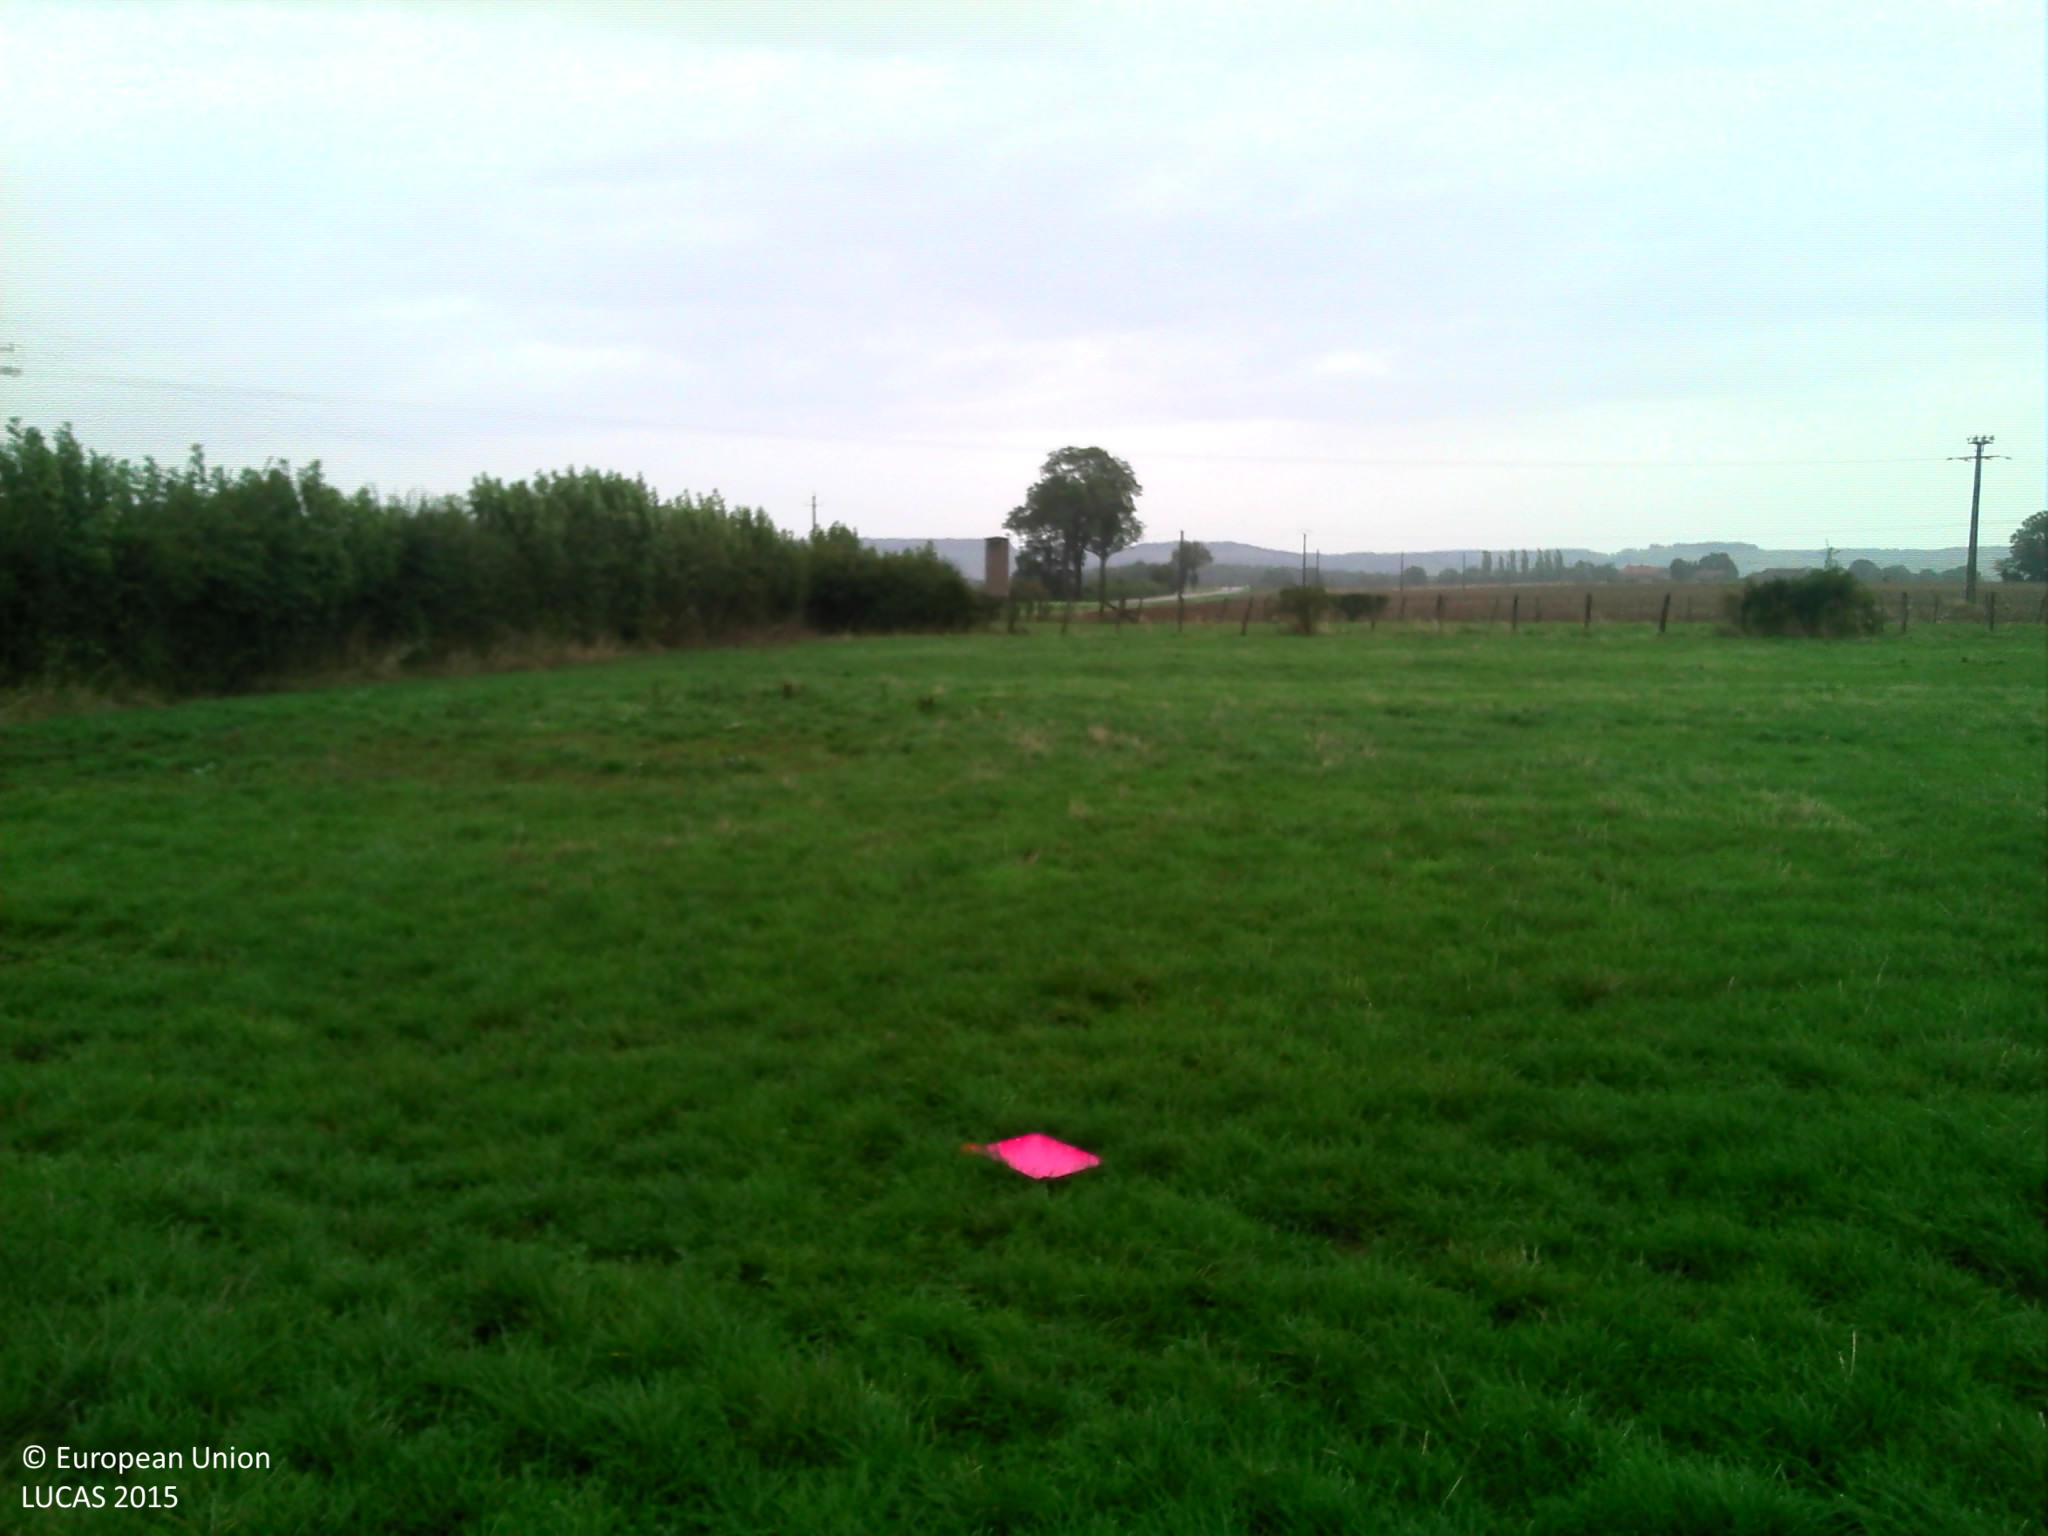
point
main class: Grassland
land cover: Grassland without tree/shrub cover
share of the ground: > 75 %
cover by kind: herbaceous plants 100 %
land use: Agriculture (excluding fallow land and kitchen gardens)
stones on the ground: < 10 %
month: September
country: FR
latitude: 47.4631
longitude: 4.3076
